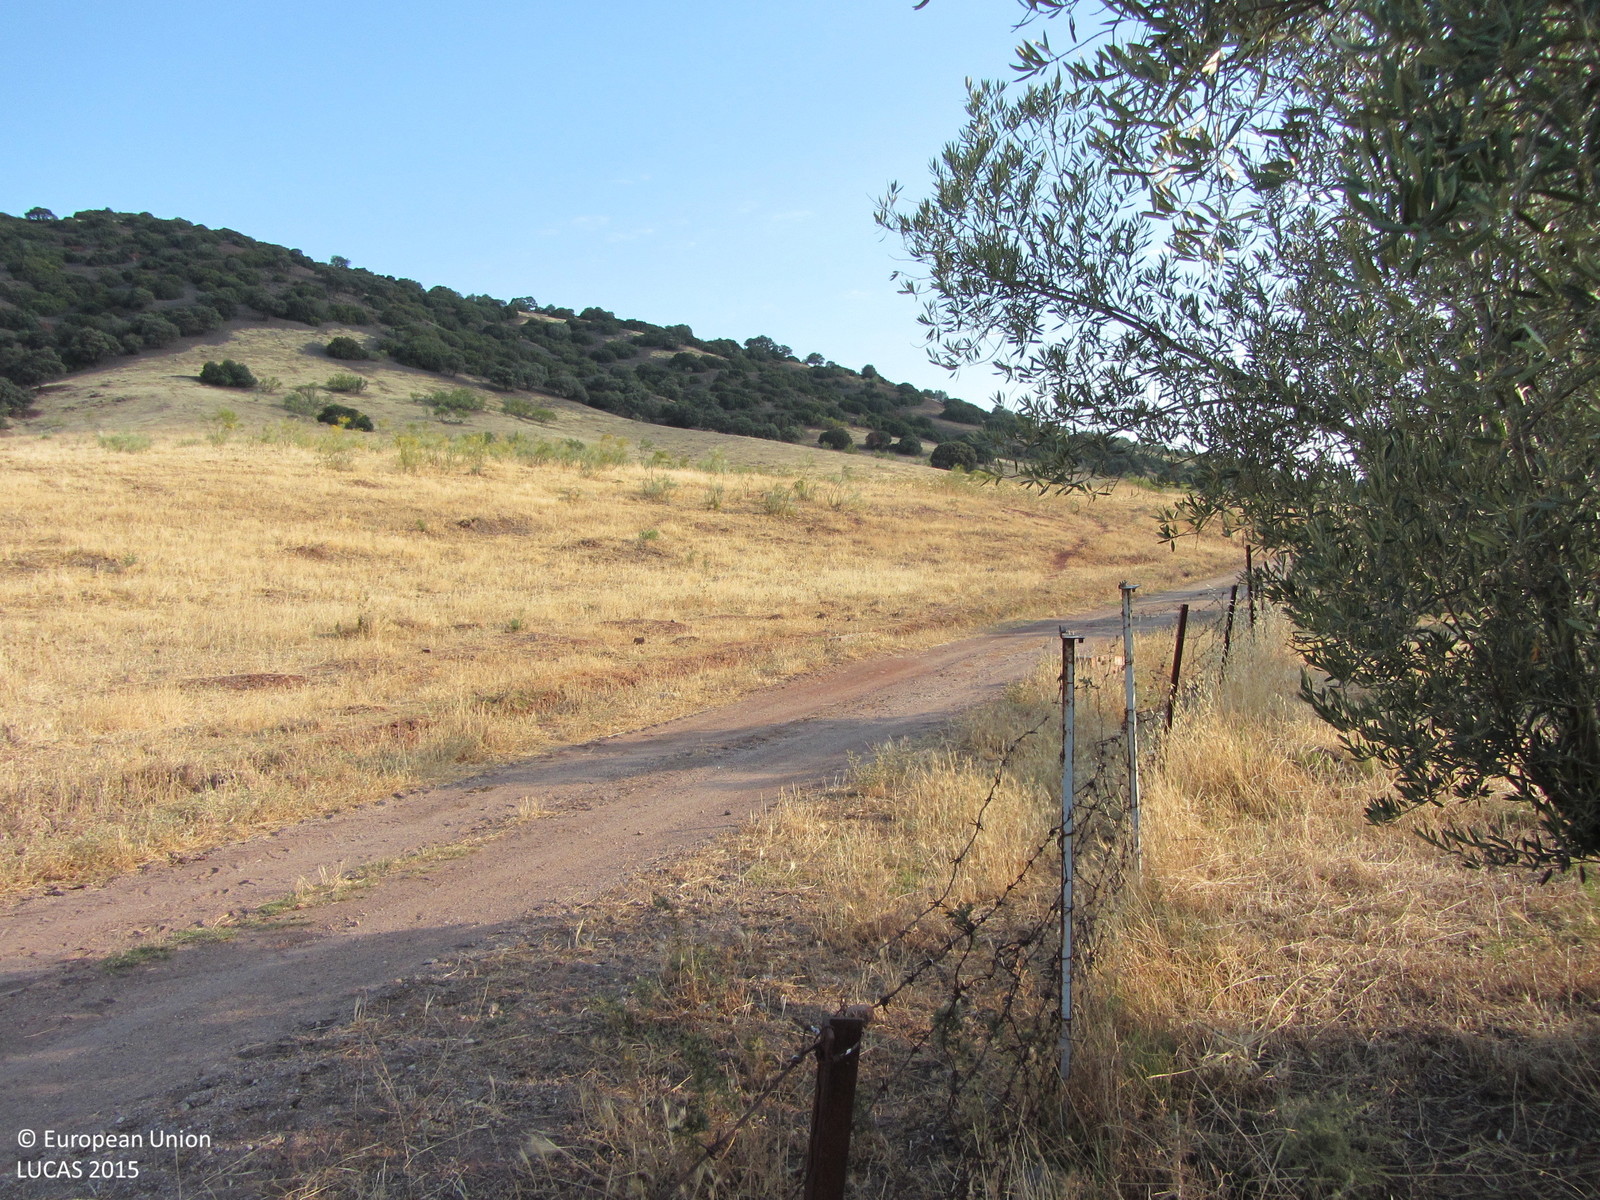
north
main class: Grassland
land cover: Grassland without tree/shrub cover
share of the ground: > 75 %
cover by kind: herbaceous plants 100 %
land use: Agriculture (excluding fallow land and kitchen gardens)
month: June
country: ES
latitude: 38.1476
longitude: -3.4333
